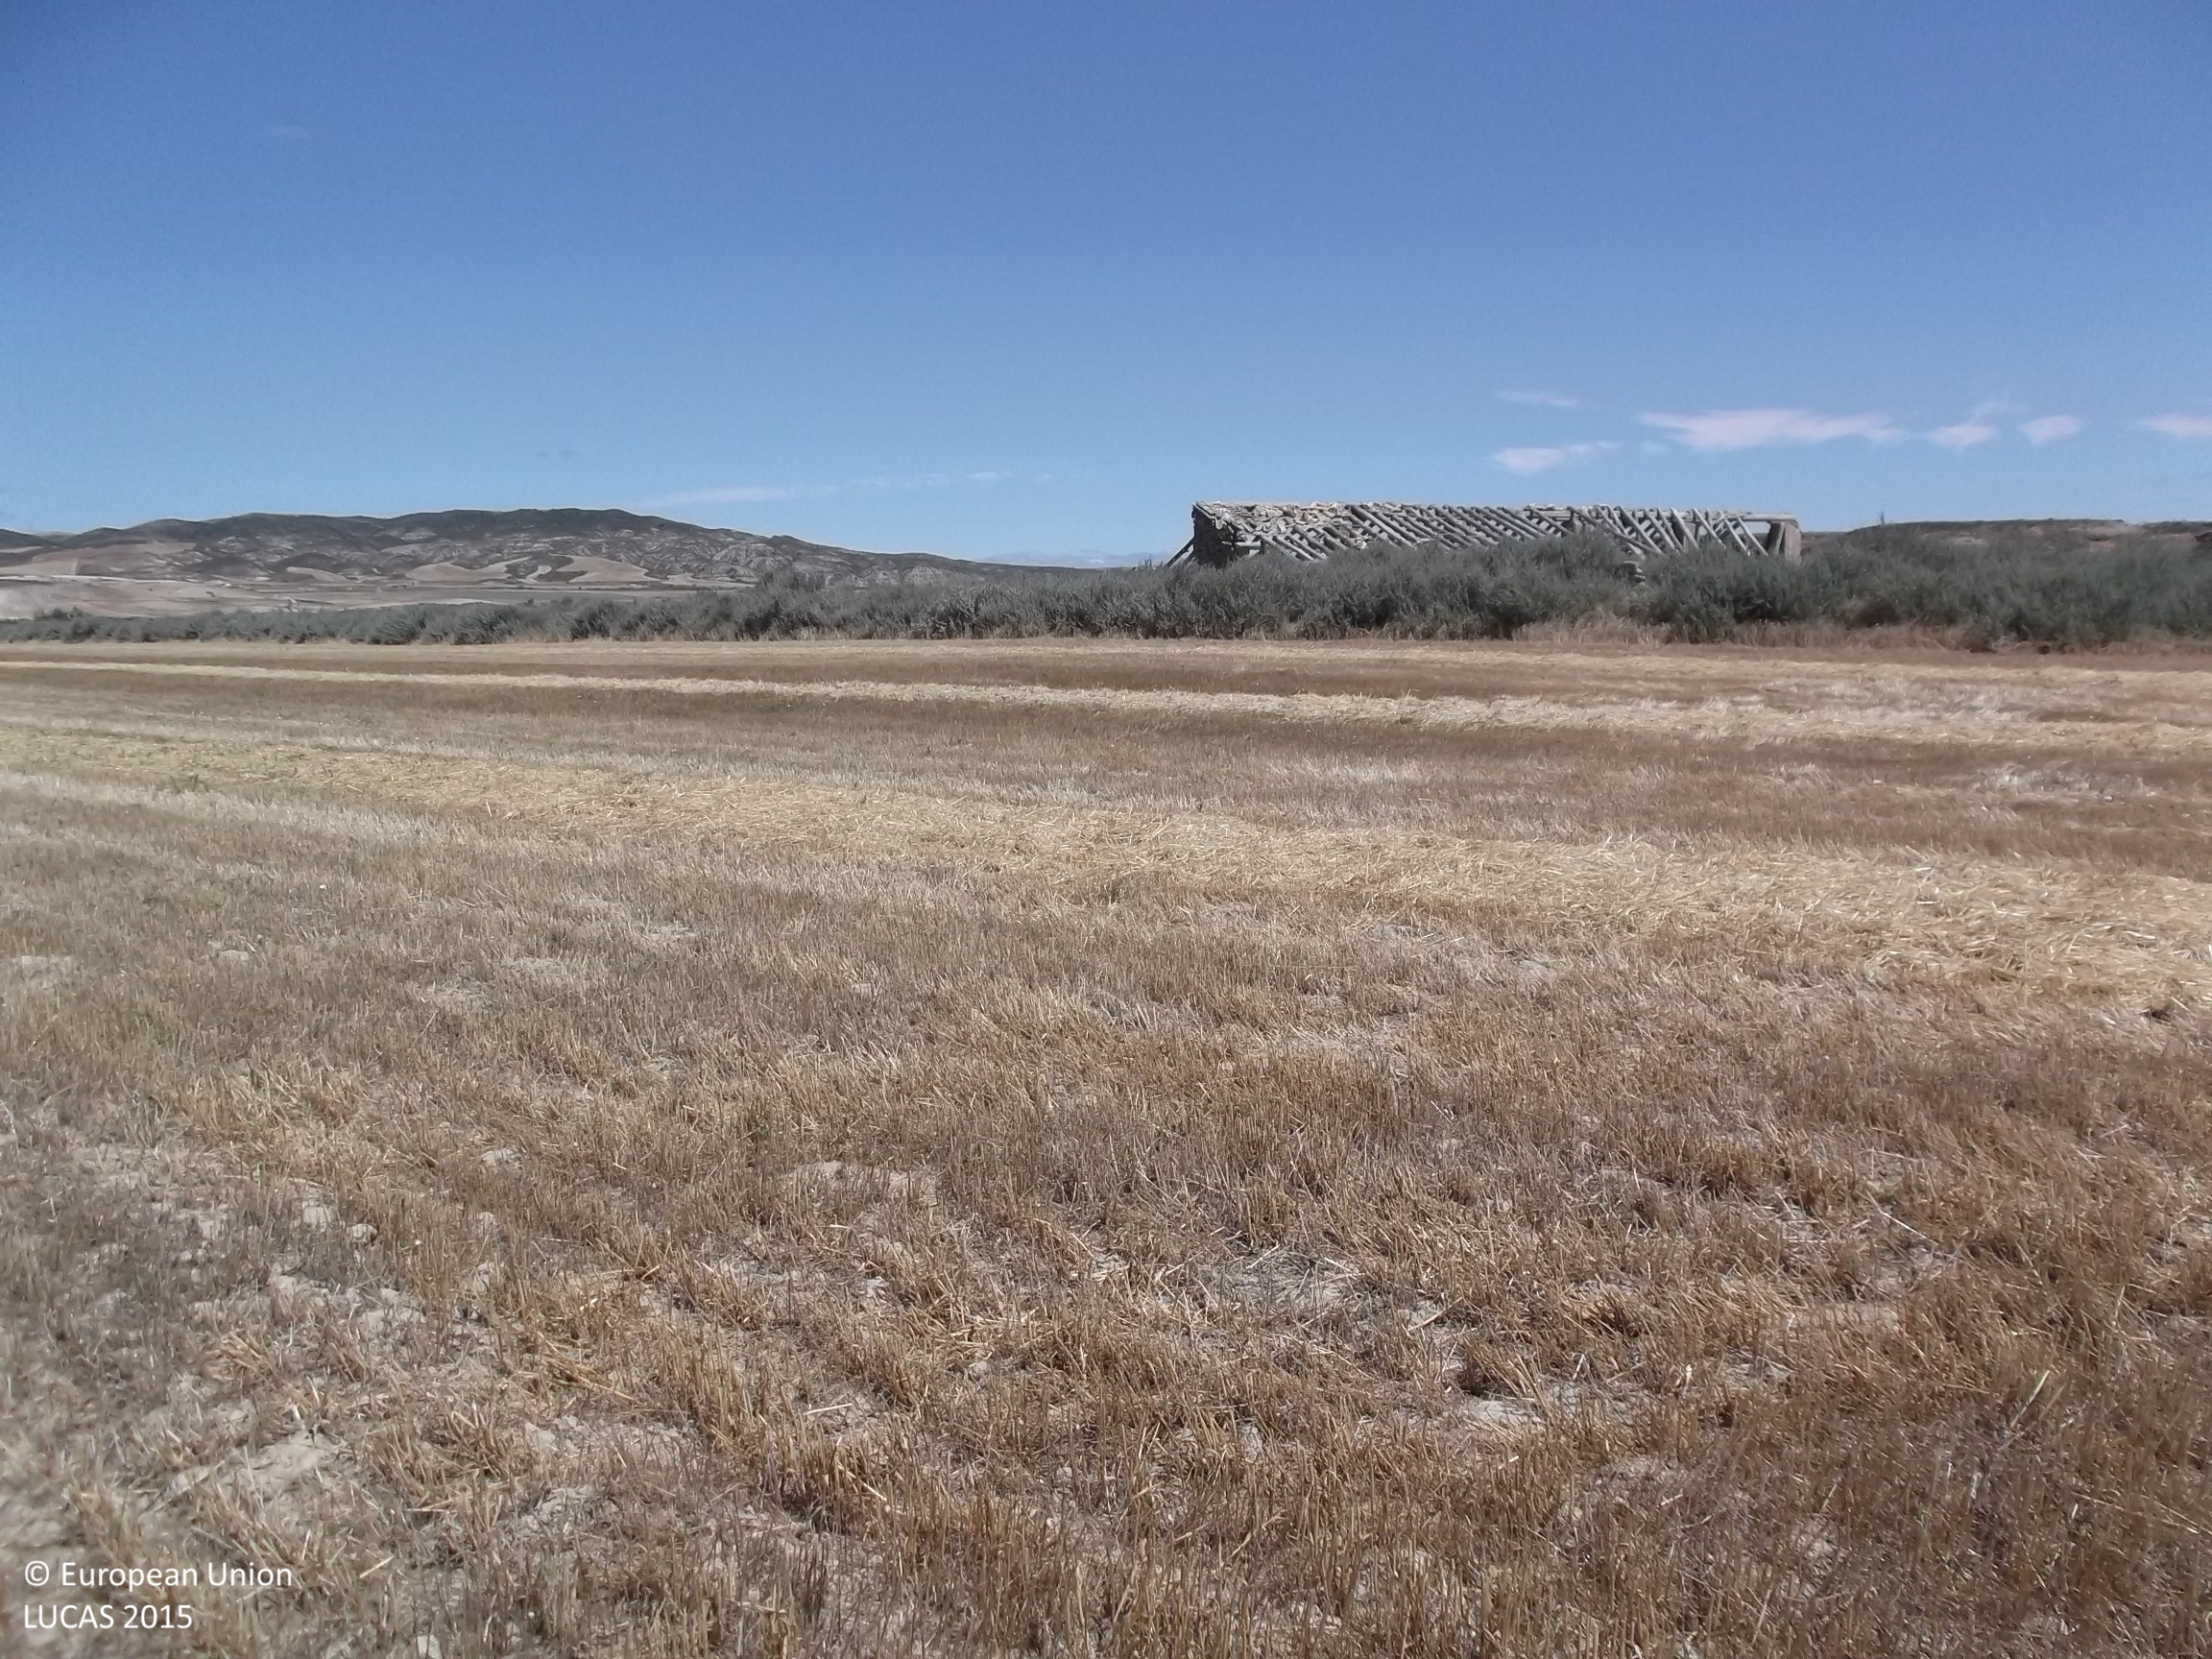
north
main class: Cropland
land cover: Barley
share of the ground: < 10 %
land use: Agriculture (excluding fallow land and kitchen gardens)
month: July
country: ES
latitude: 42.1560
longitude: -1.5415
